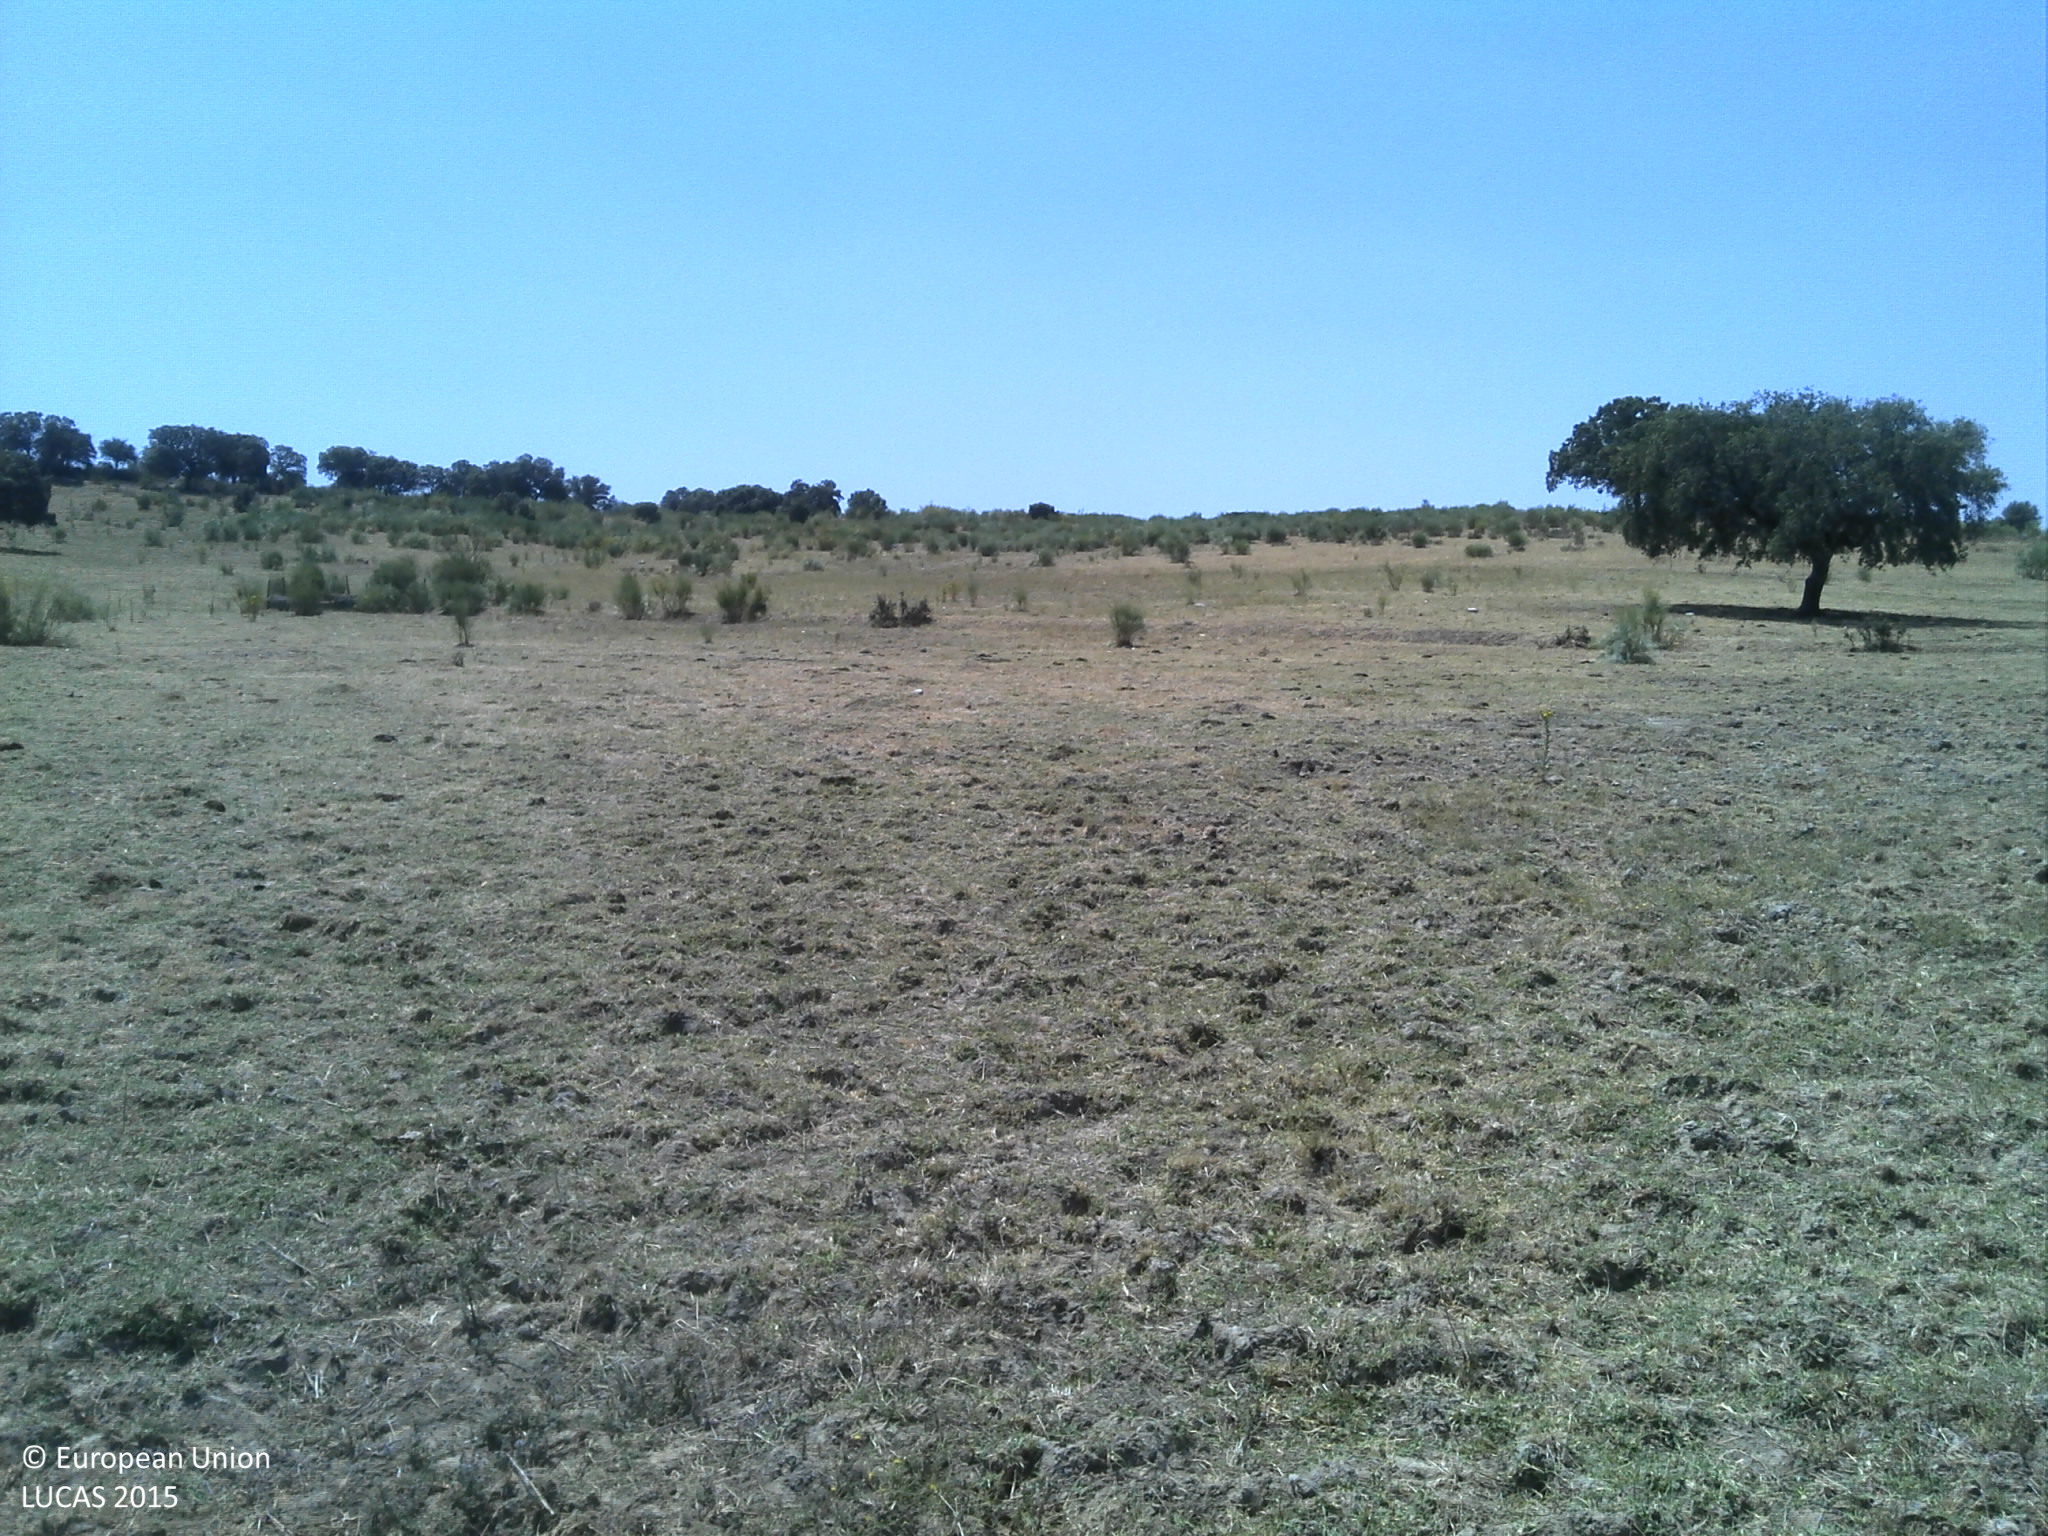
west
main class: Grassland
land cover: Grassland without tree/shrub cover
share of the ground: 10 - 25 %
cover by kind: unconsolidated bare surface 65 %, herbaceous plants 25 %, shrubs 5 %
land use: Agriculture (excluding fallow land and kitchen gardens)
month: June
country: PT
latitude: 39.7737
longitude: -7.1708
